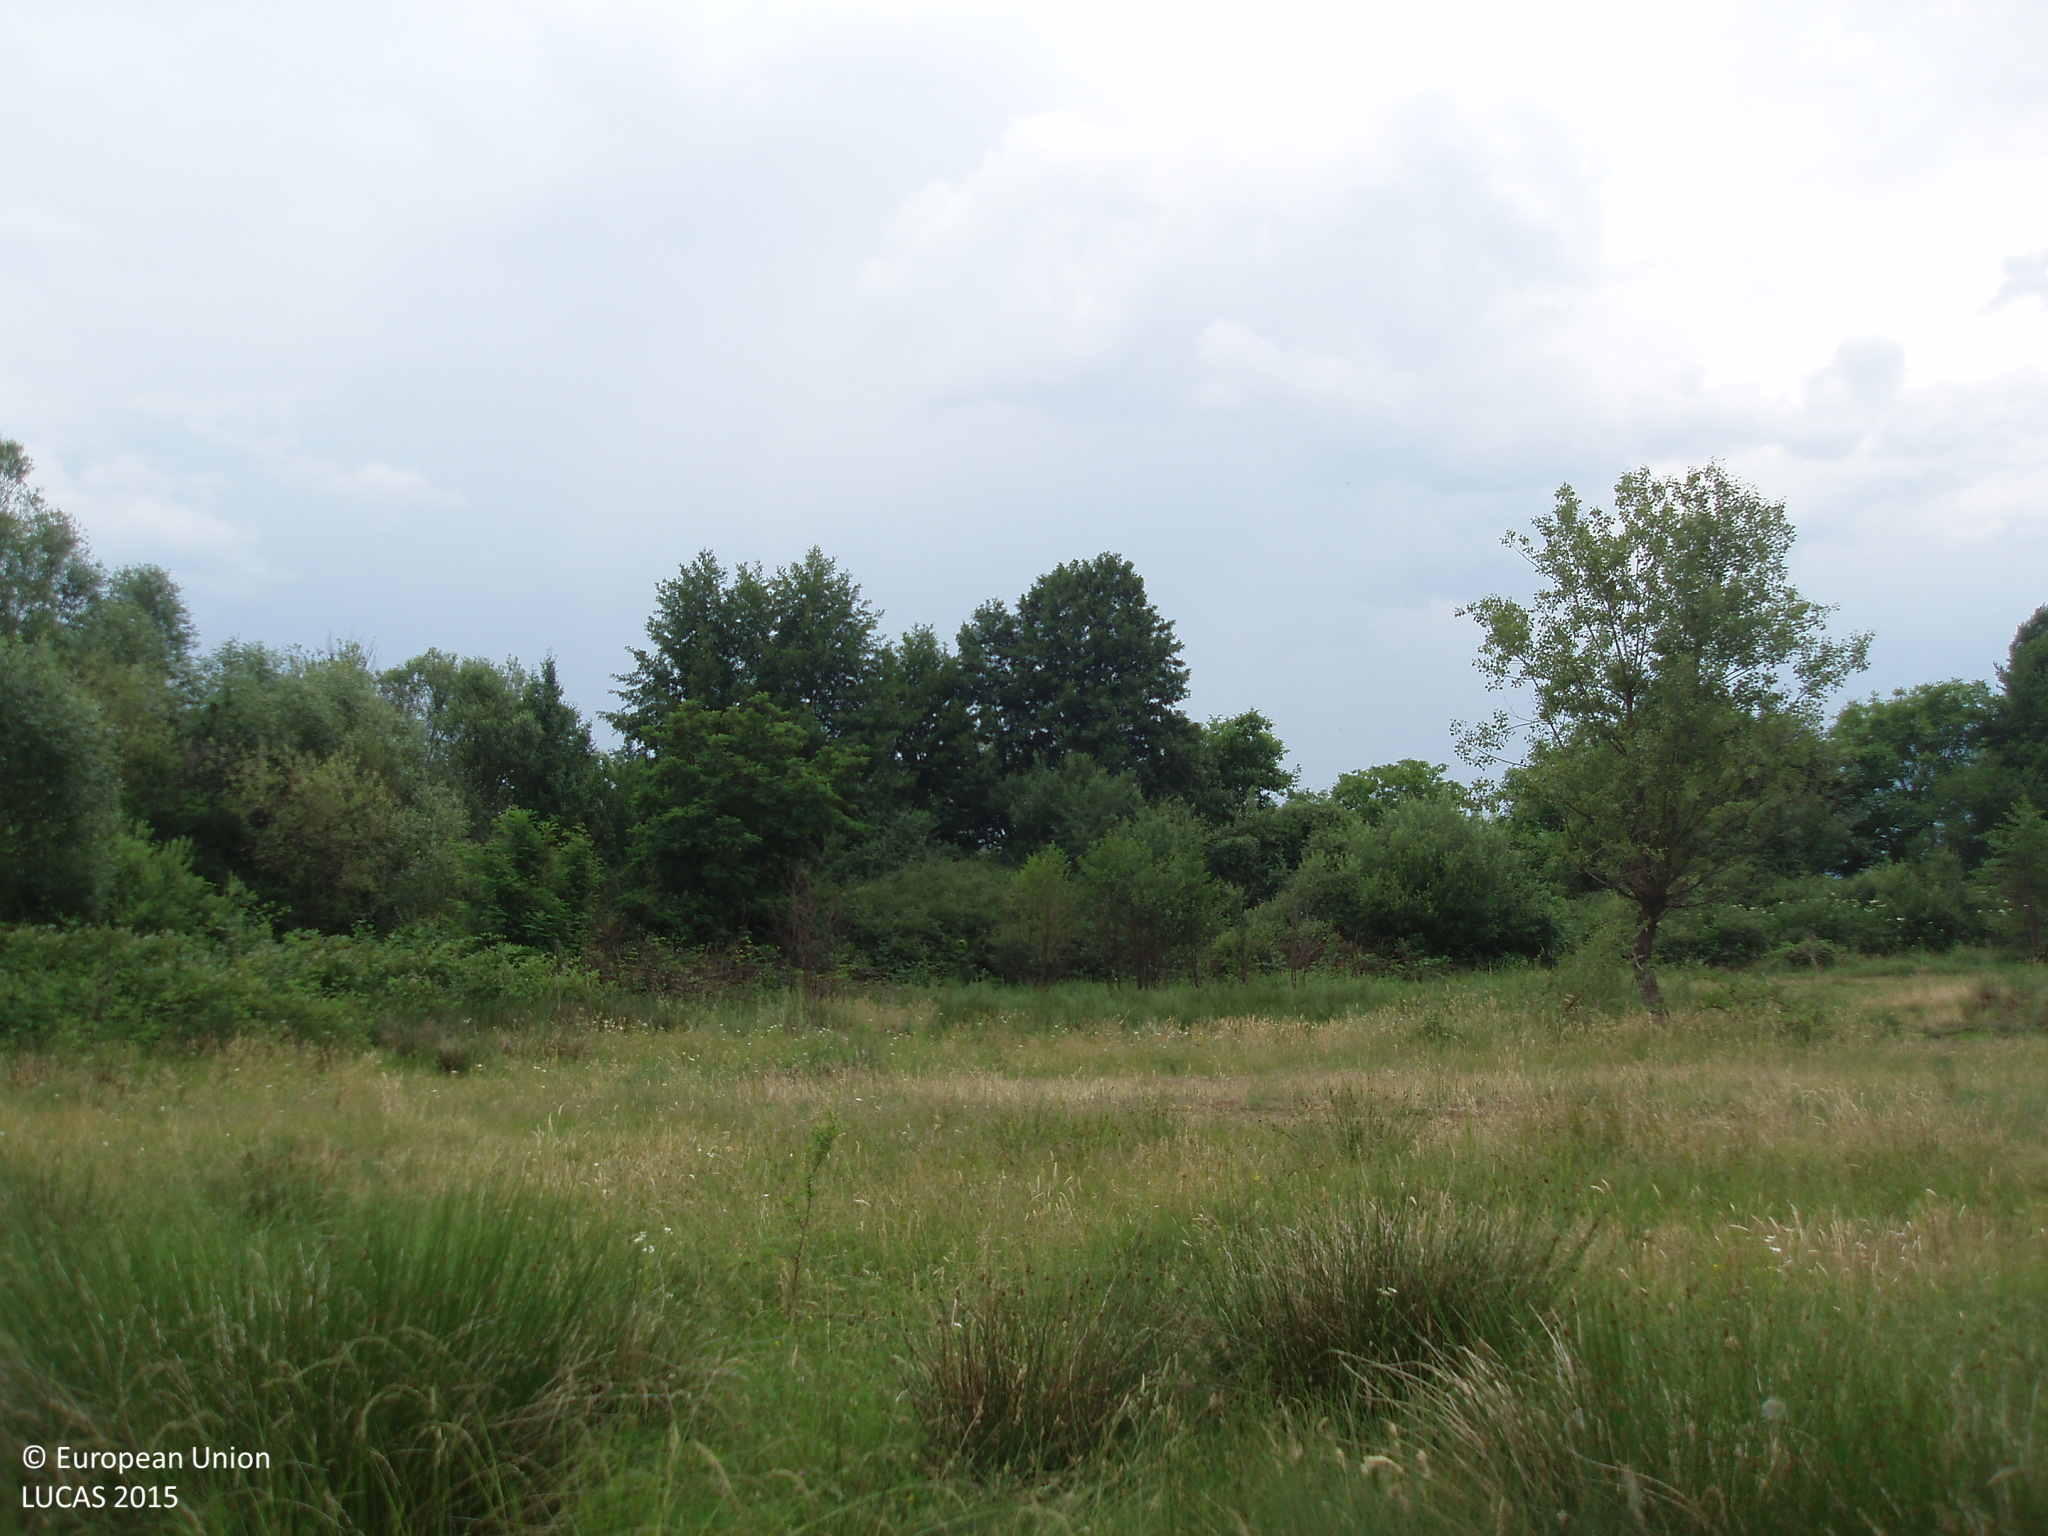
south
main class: Grassland
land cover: Grassland without tree/shrub cover
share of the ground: > 75 %
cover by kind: herbaceous plants 100 %
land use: Agriculture (excluding fallow land and kitchen gardens)
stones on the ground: 10 - 25 %
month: June
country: BG
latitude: 41.6202
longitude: 23.7469
